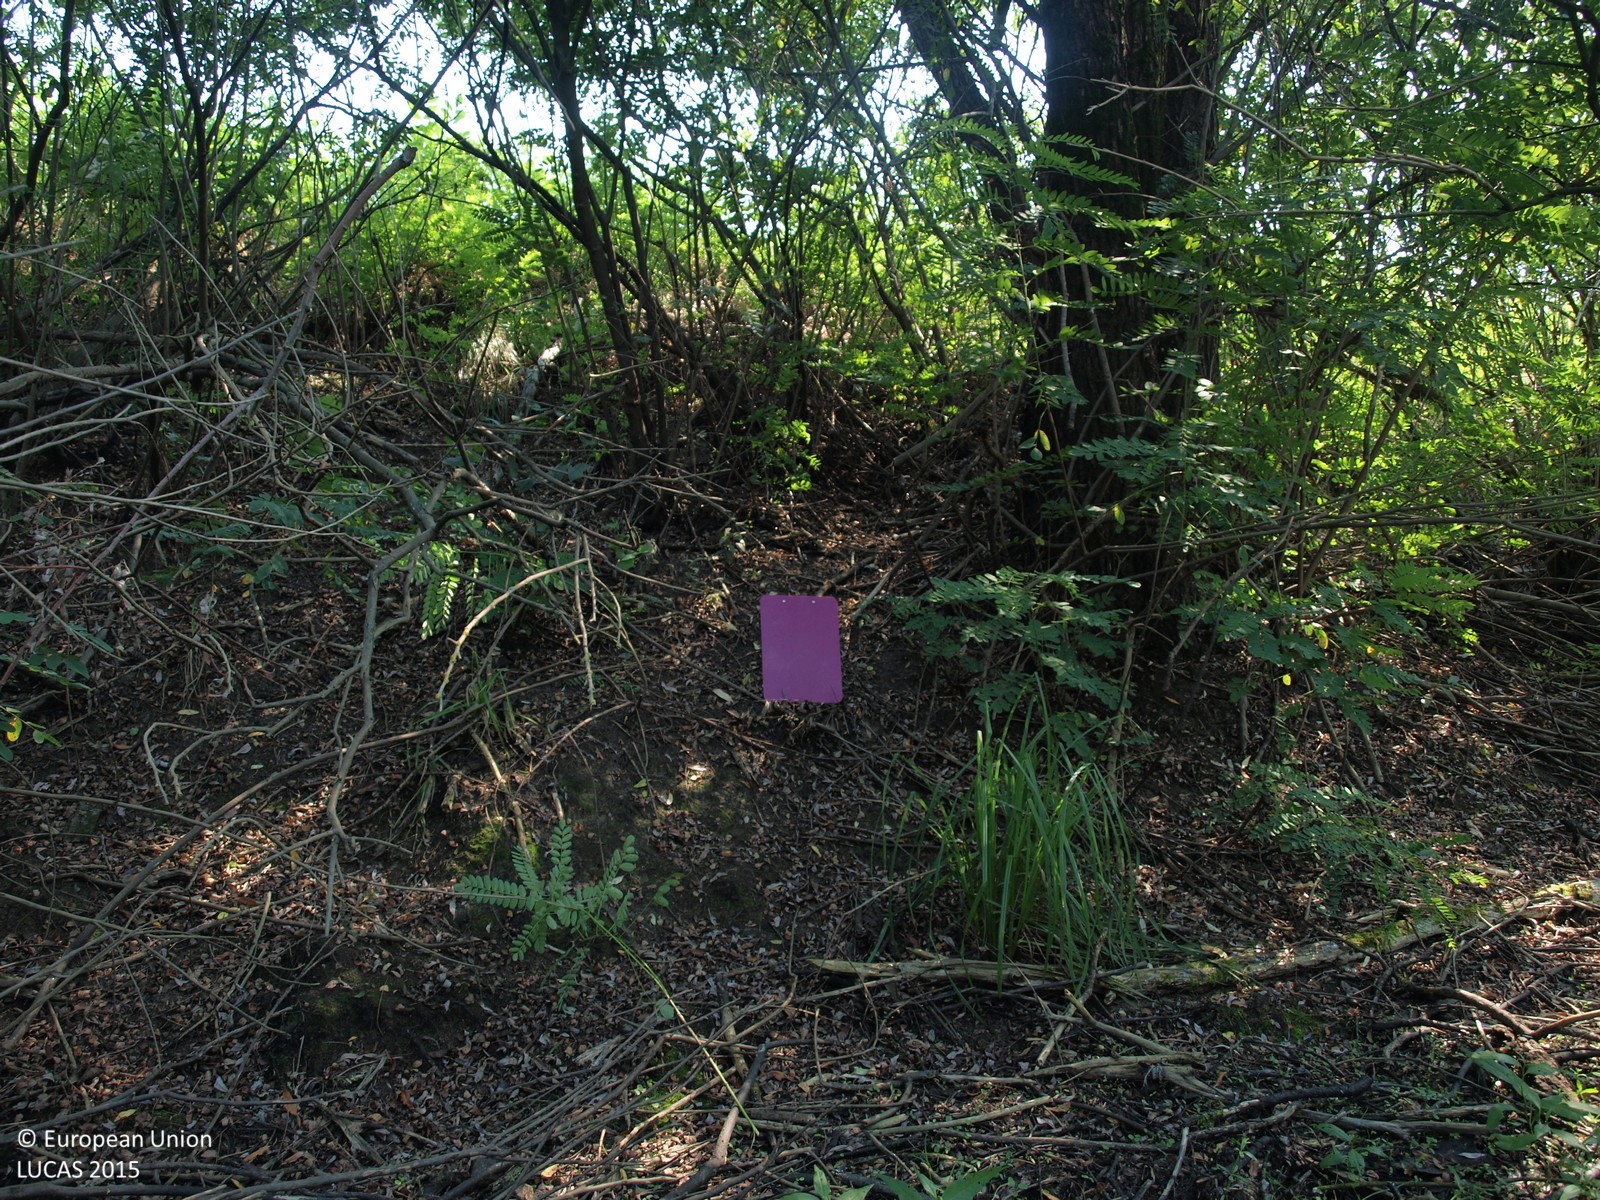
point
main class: Shrubland
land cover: Shrubland with sparse tree cover
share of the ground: > 75 %
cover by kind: shrubs 95 %, broadleaved forest trees 5 %
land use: Semi-natural and natural areas not in use
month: August
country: HR
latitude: 45.8149
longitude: 16.4209
